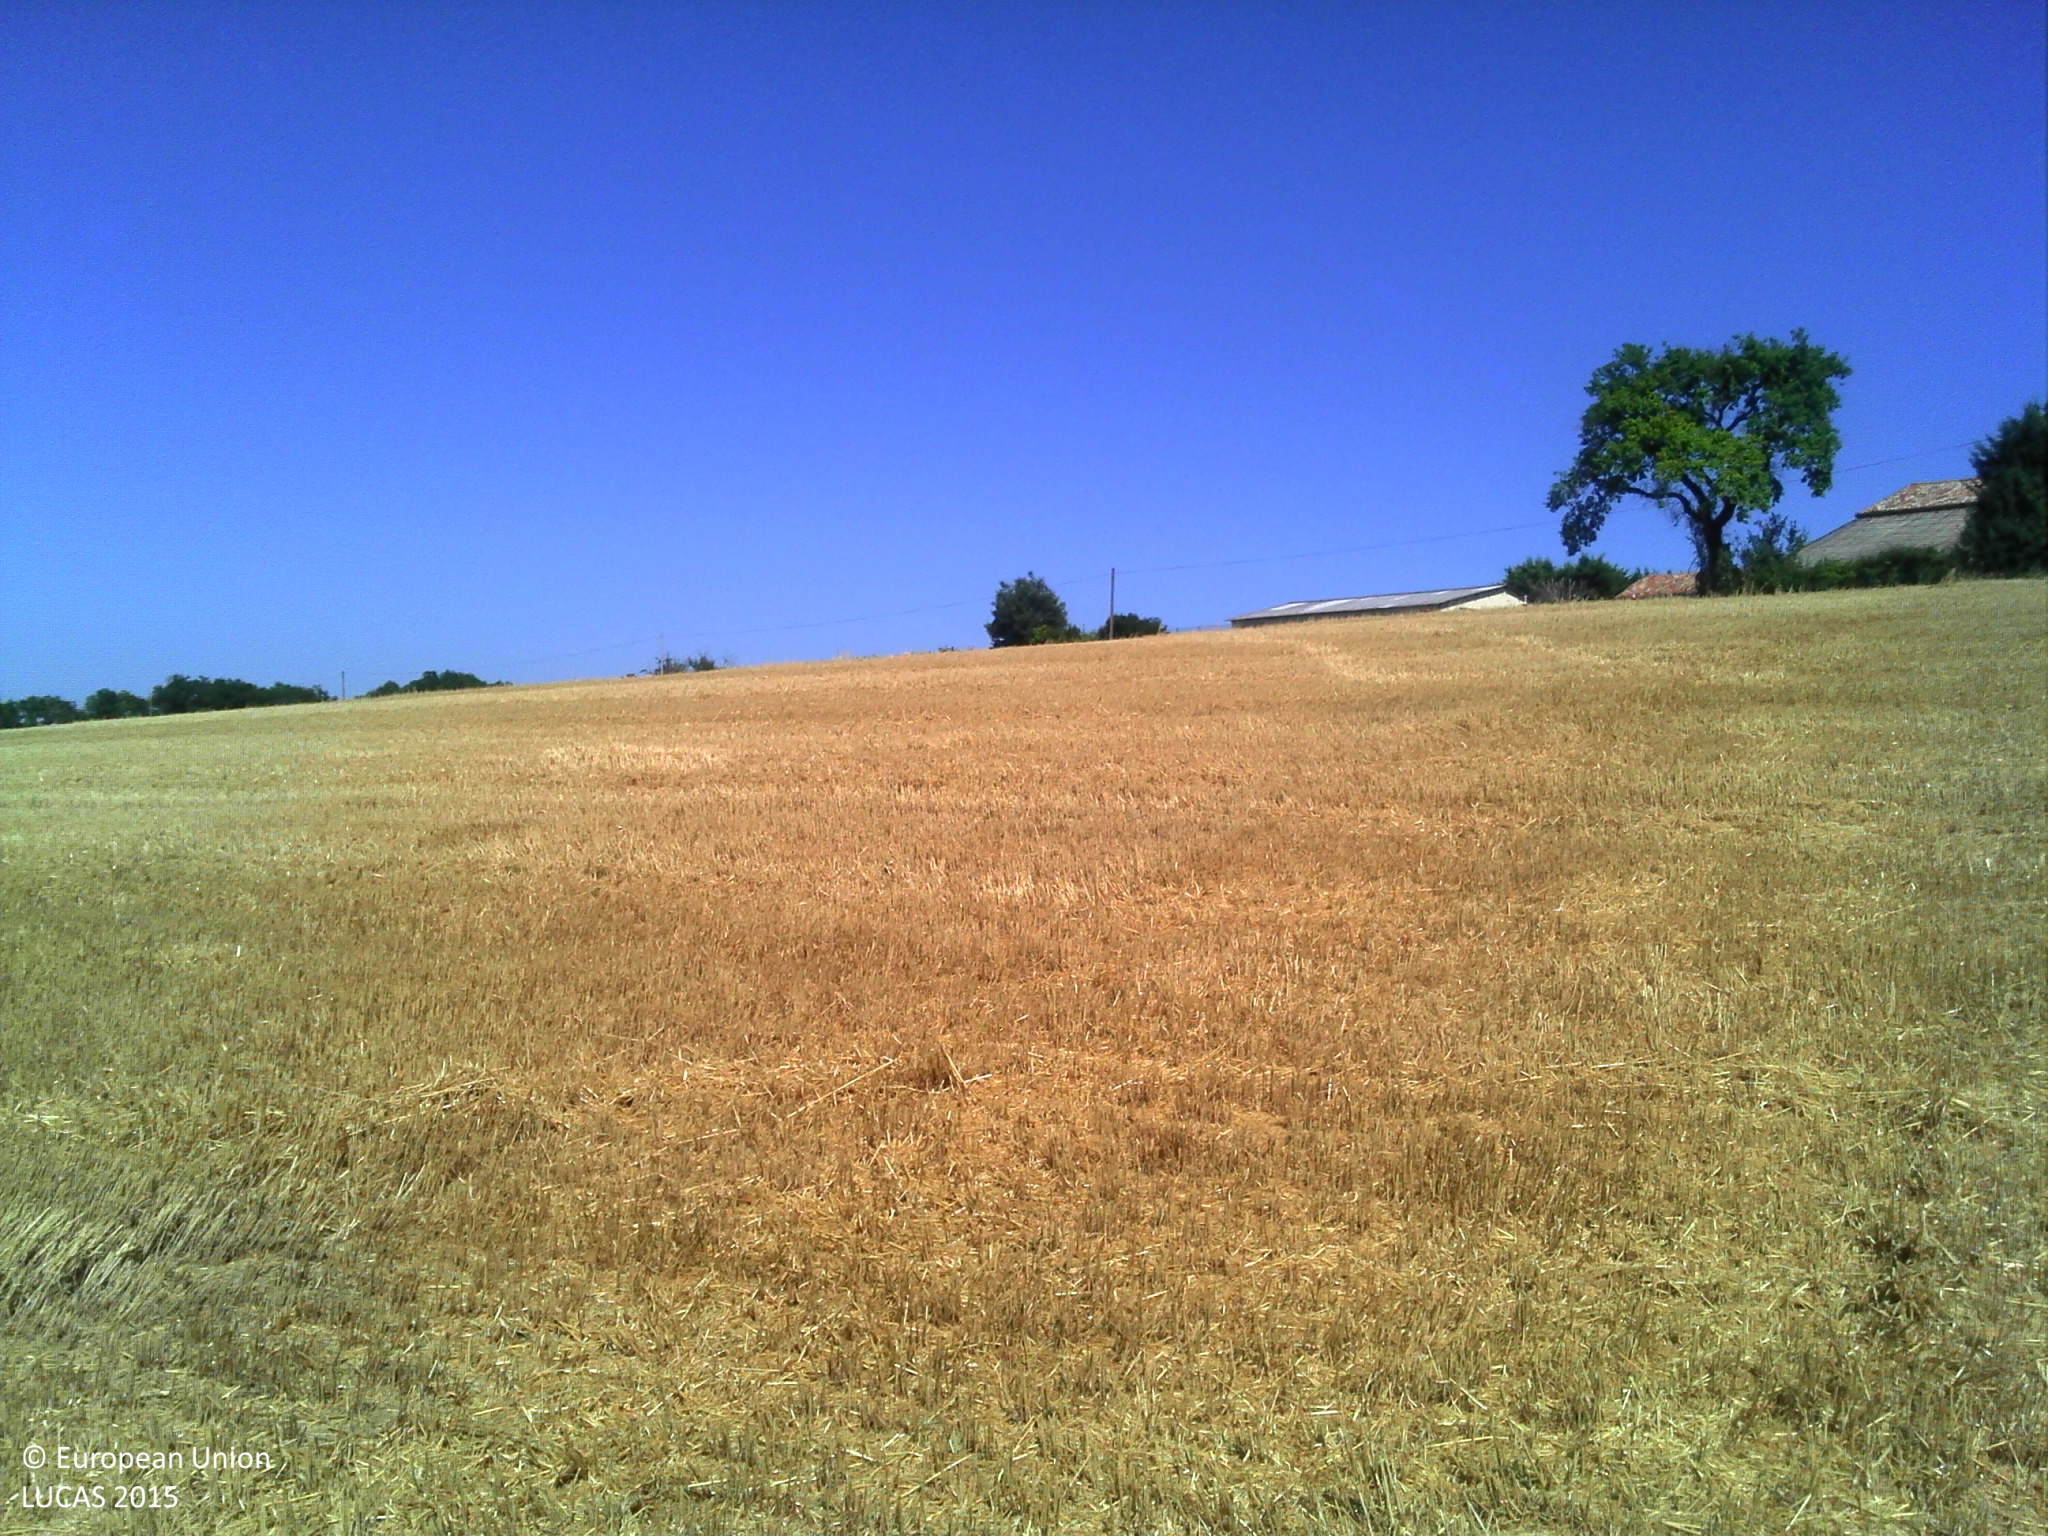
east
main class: Cropland
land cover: Common wheat
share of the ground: > 75 %
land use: Agriculture (excluding fallow land and kitchen gardens)
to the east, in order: Common wheat; Grass margins; Electric lines; Paved roads, cycling and walking lanes; Ditches and canals; Single bushes/trees; Tracks; Fences; Grassland without tree/shrub cover; Fences; Spontaneously vegetated surfaces; Artificial constructions; Sunflower
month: July
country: FR
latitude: 43.9470
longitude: 0.6640
